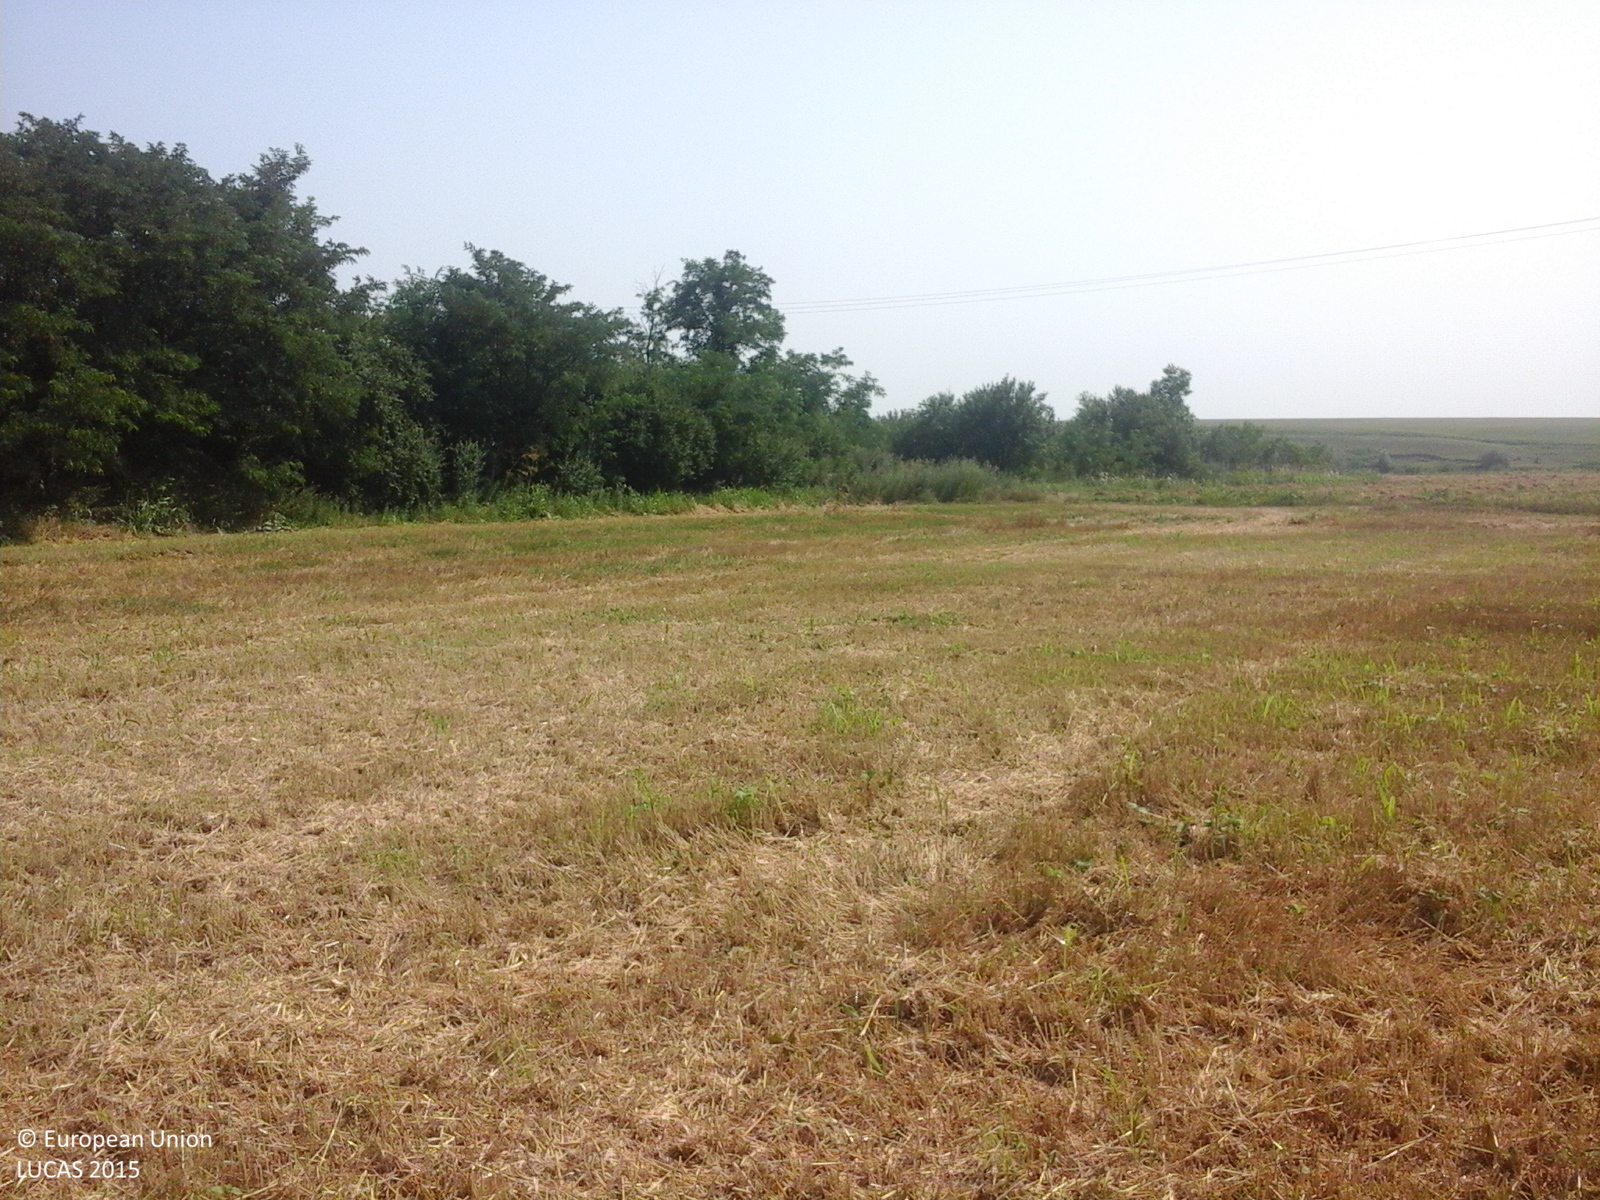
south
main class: Cropland
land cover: Common wheat
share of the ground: 50 - 75 %
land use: Agriculture (excluding fallow land and kitchen gardens)
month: July
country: RO
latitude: 44.5709
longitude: 26.4472
